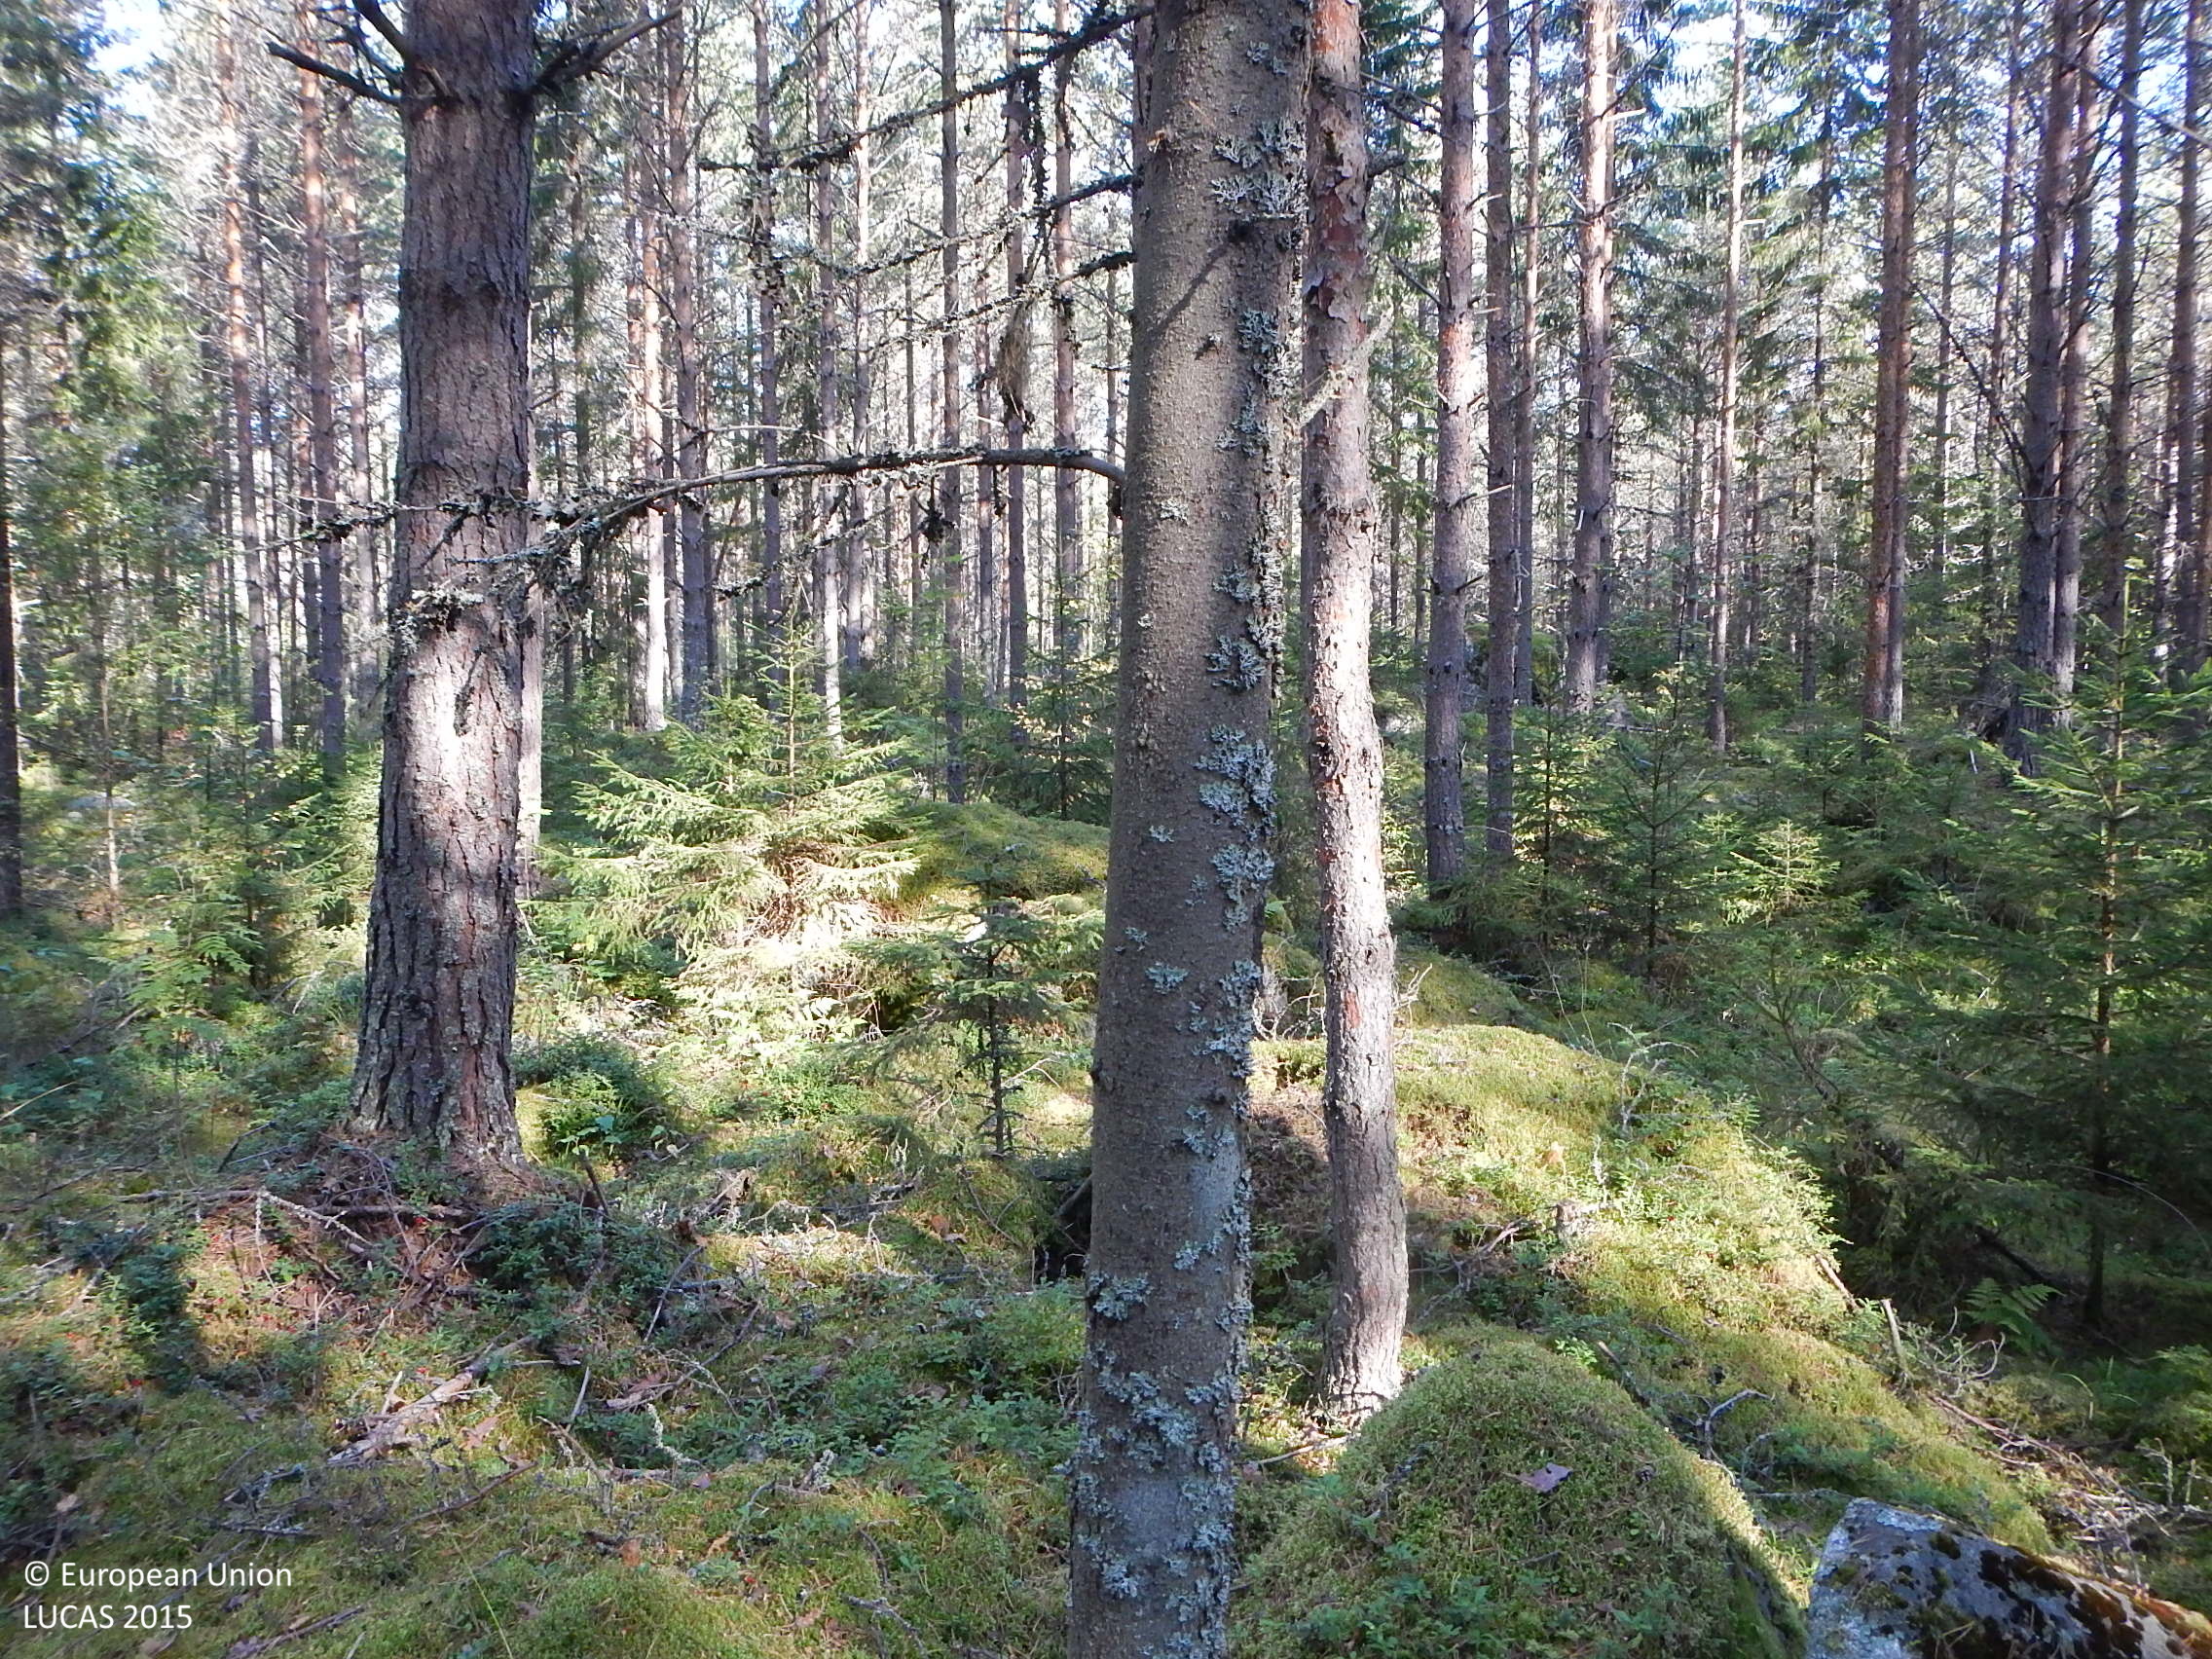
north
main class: Woodland
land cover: Pine dominated coniferous woodland
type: boreal forest
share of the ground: > 75 %
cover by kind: coniferous forest trees 75 %, lichens and mosses 25 %
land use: Forestry
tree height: > 5 m
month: September
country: FI
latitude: 61.6250
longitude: 22.1485
